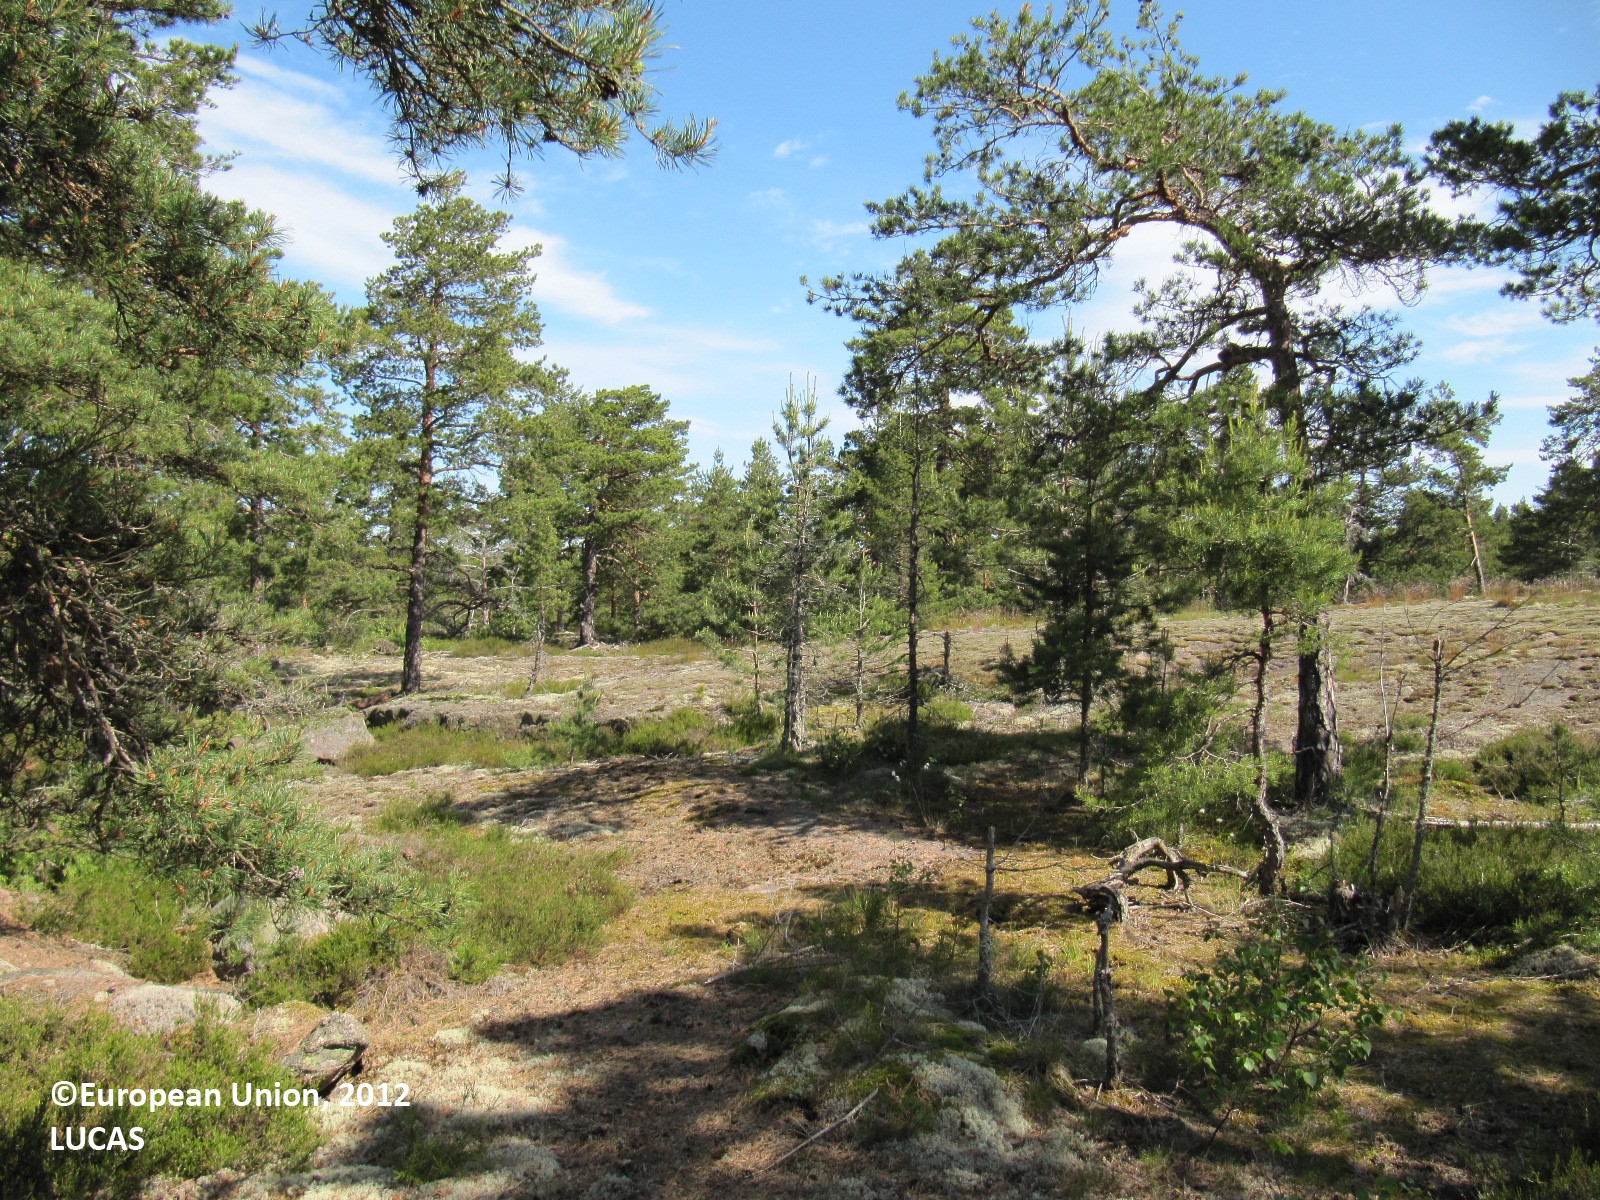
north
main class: Woodland
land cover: Pine dominated coniferous woodland
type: boreal forest
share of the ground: 25 - 50 %
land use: Forestry
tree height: > 5 m
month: June
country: FI
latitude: 59.9282
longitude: 22.9447
